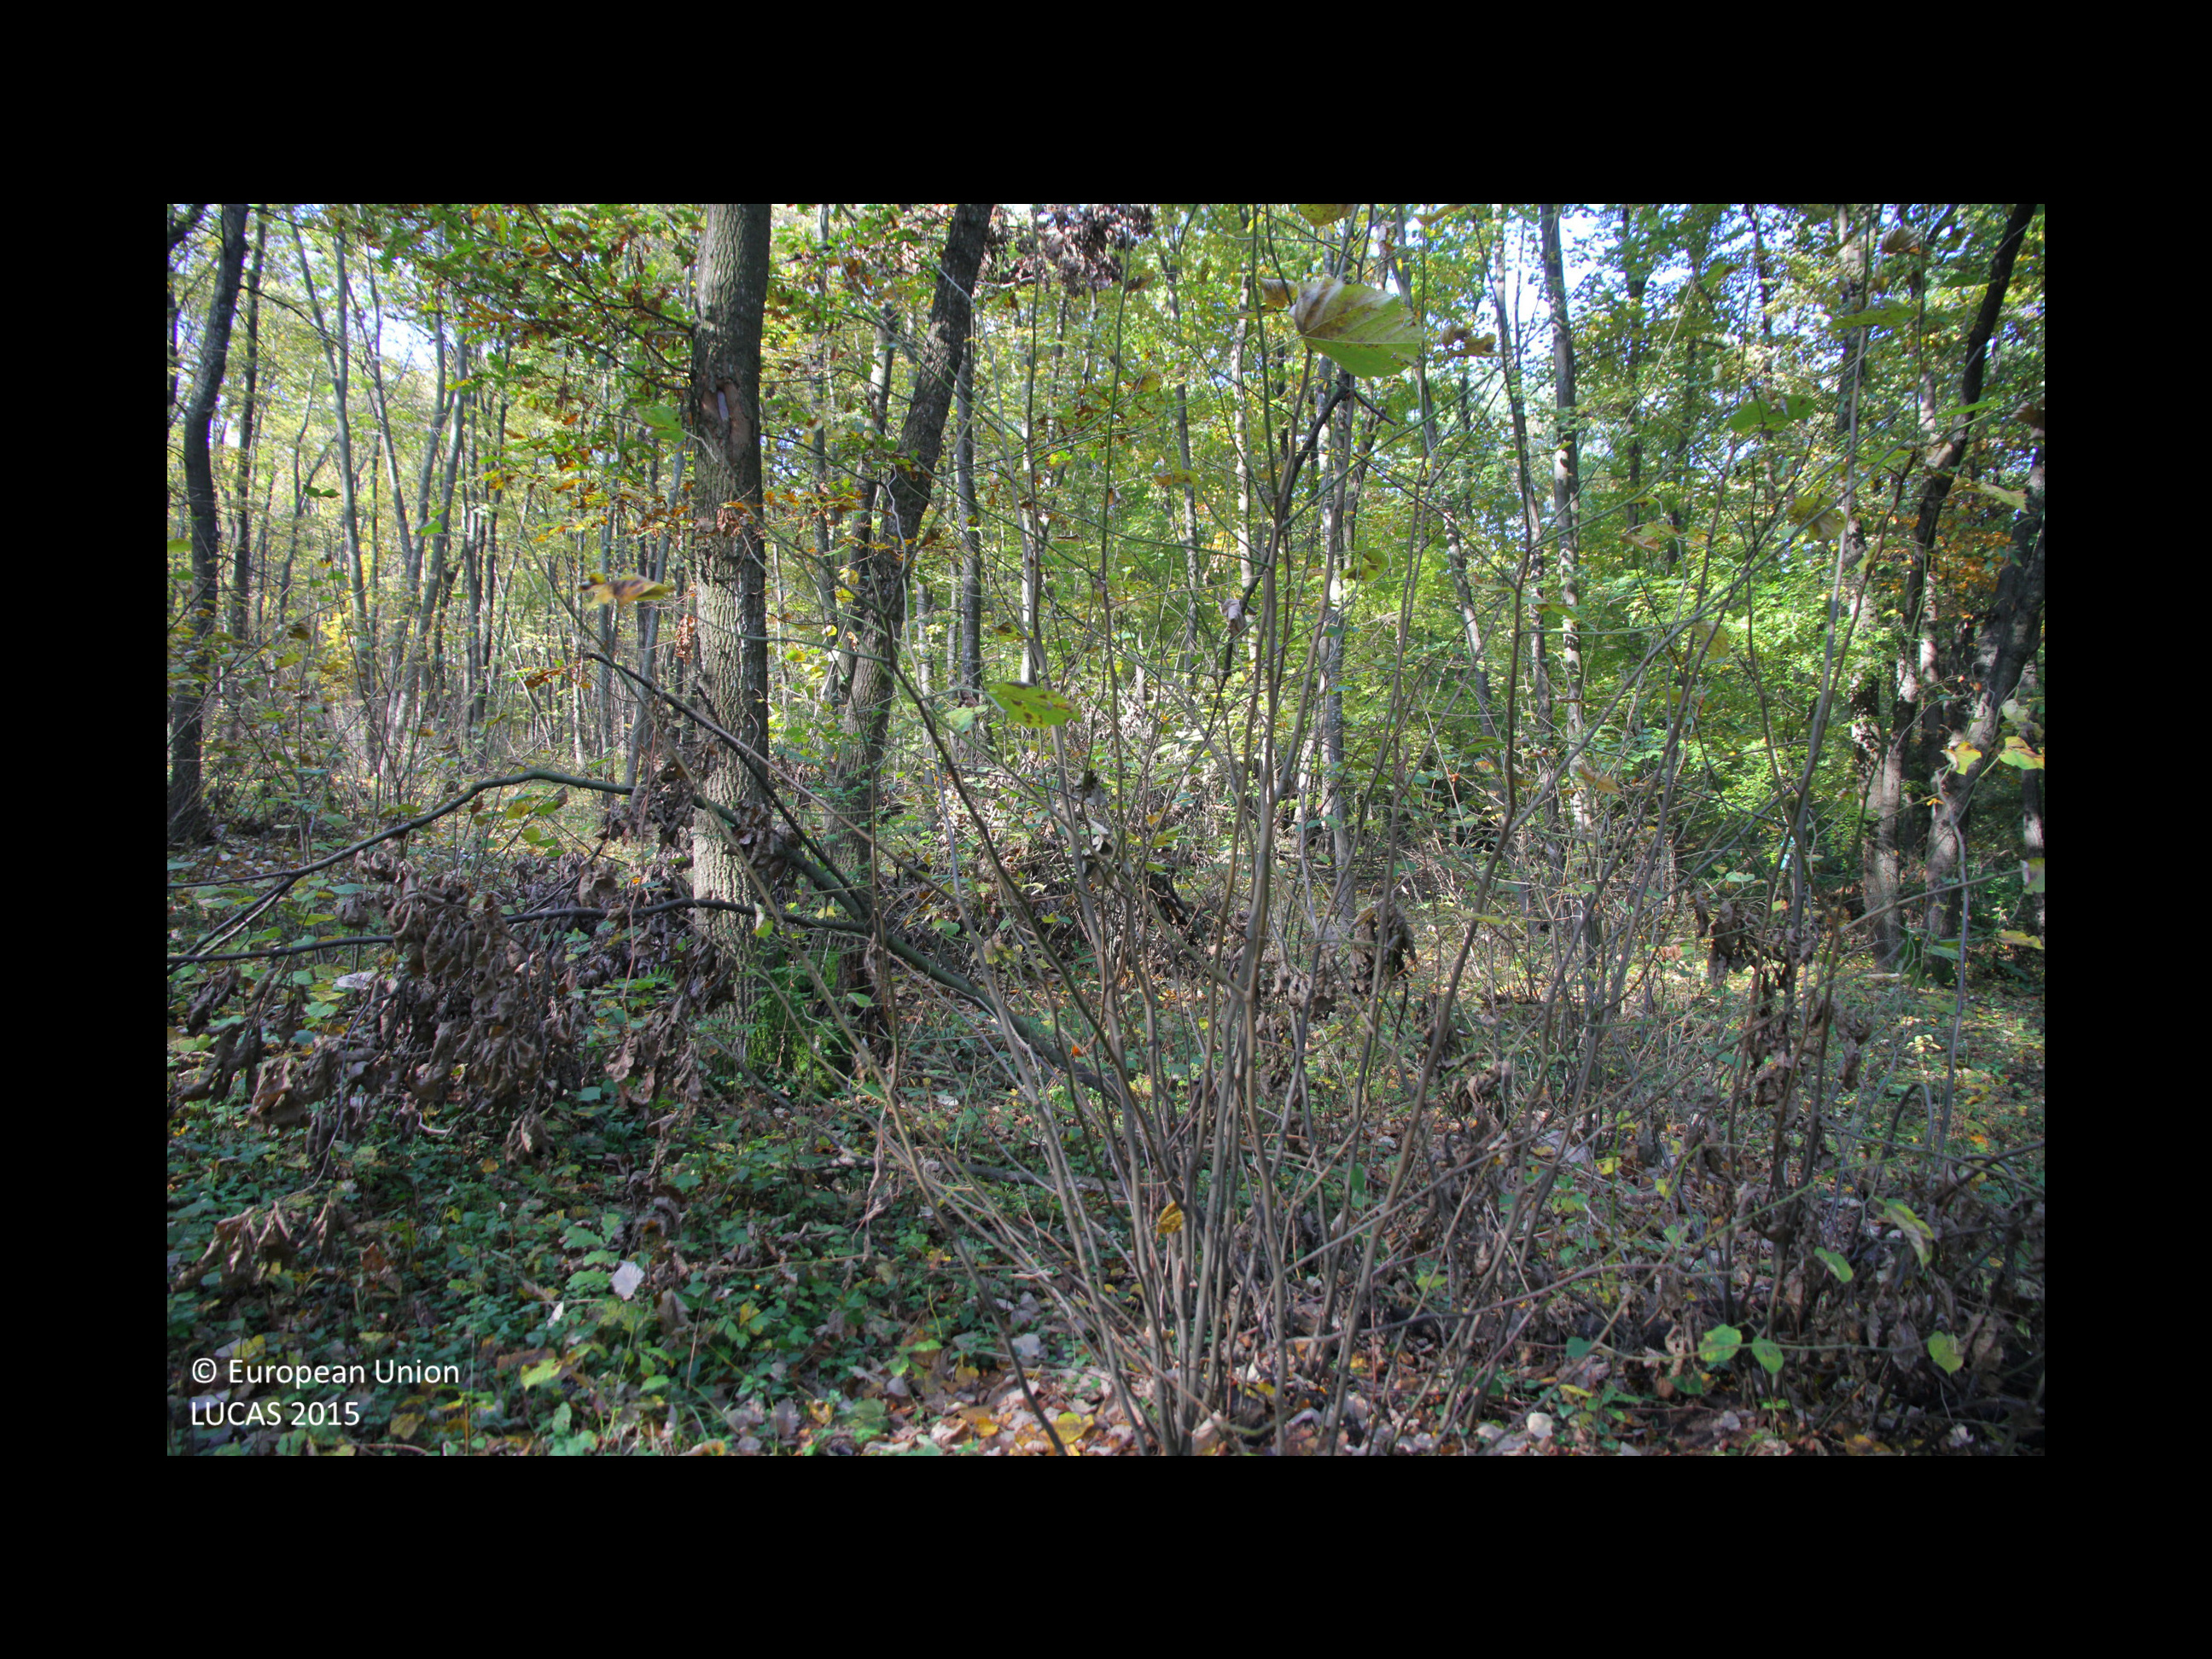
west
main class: Woodland
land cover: Broadleaved woodland
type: beech forest
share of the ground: > 75 %
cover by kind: broadleaved forest trees 90 %, herbaceous plants 5 %, unconsolidated bare surface 5 %
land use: Forestry
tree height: > 5 m
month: October
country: BG
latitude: 43.8708
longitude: 26.3443
